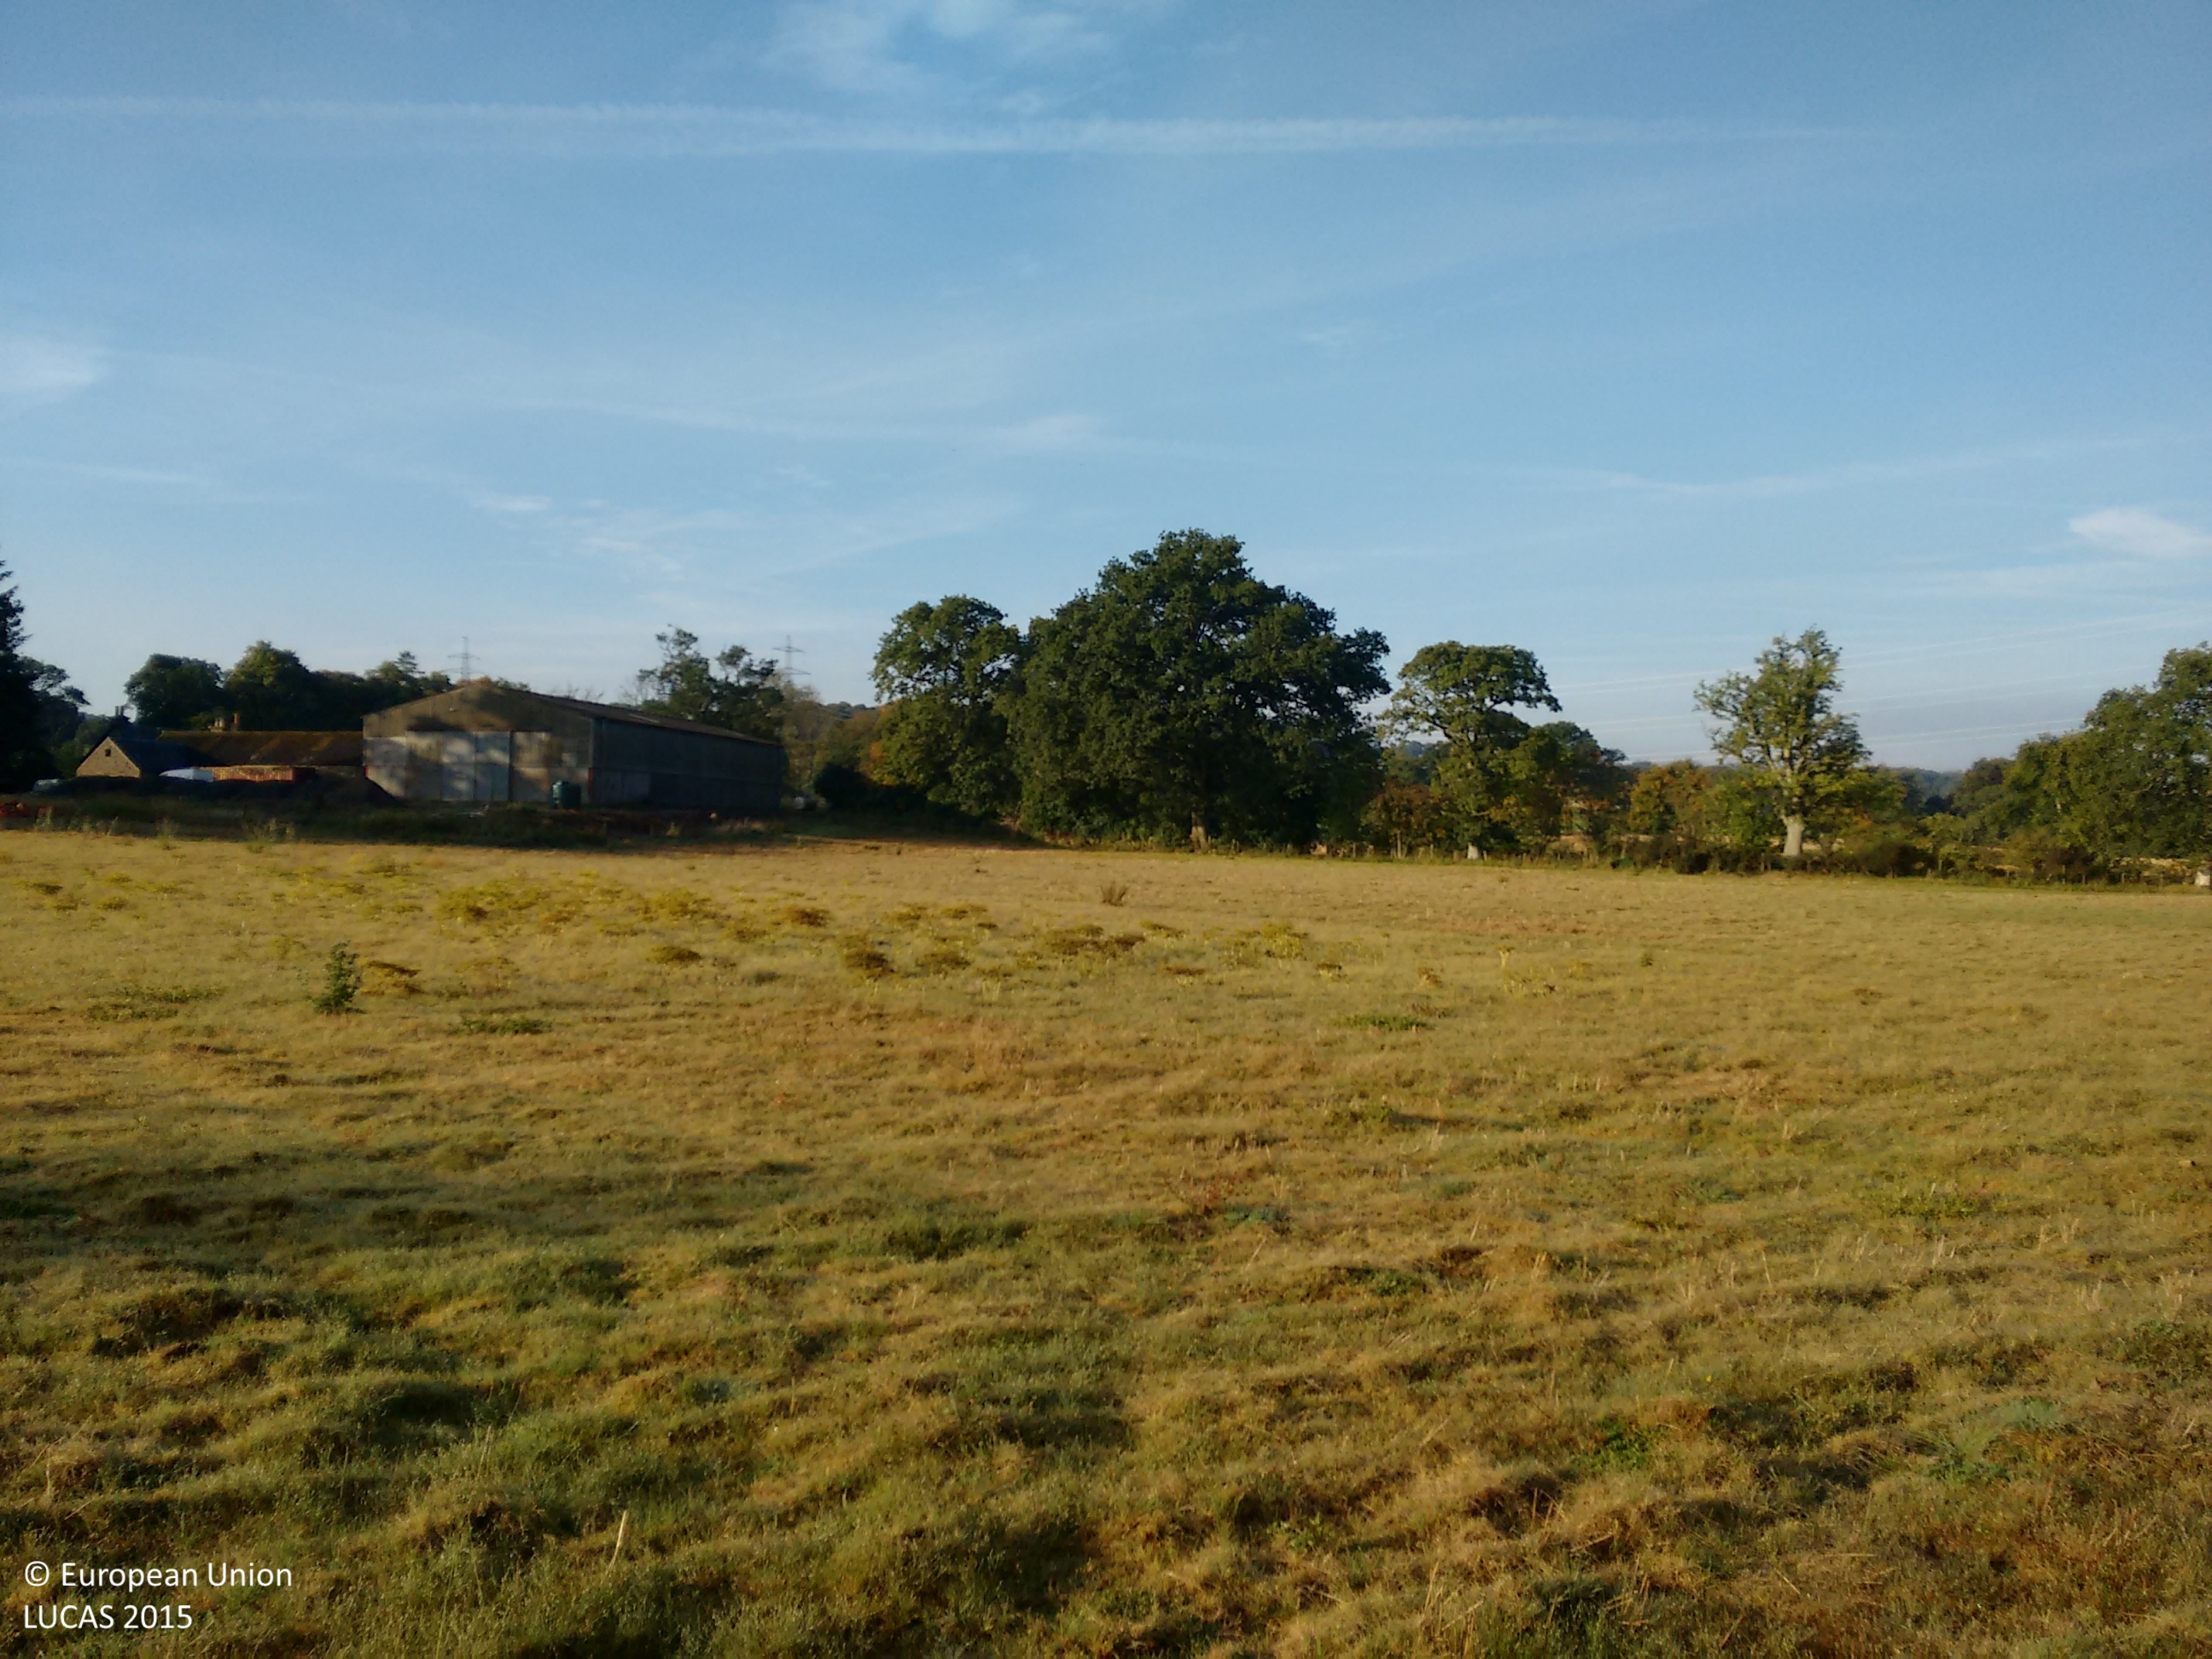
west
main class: Grassland
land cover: Grassland without tree/shrub cover
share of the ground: > 75 %
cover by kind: herbaceous plants 100 %
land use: Agriculture (excluding fallow land and kitchen gardens)
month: September
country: GB
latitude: 56.3312
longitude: -3.8133
